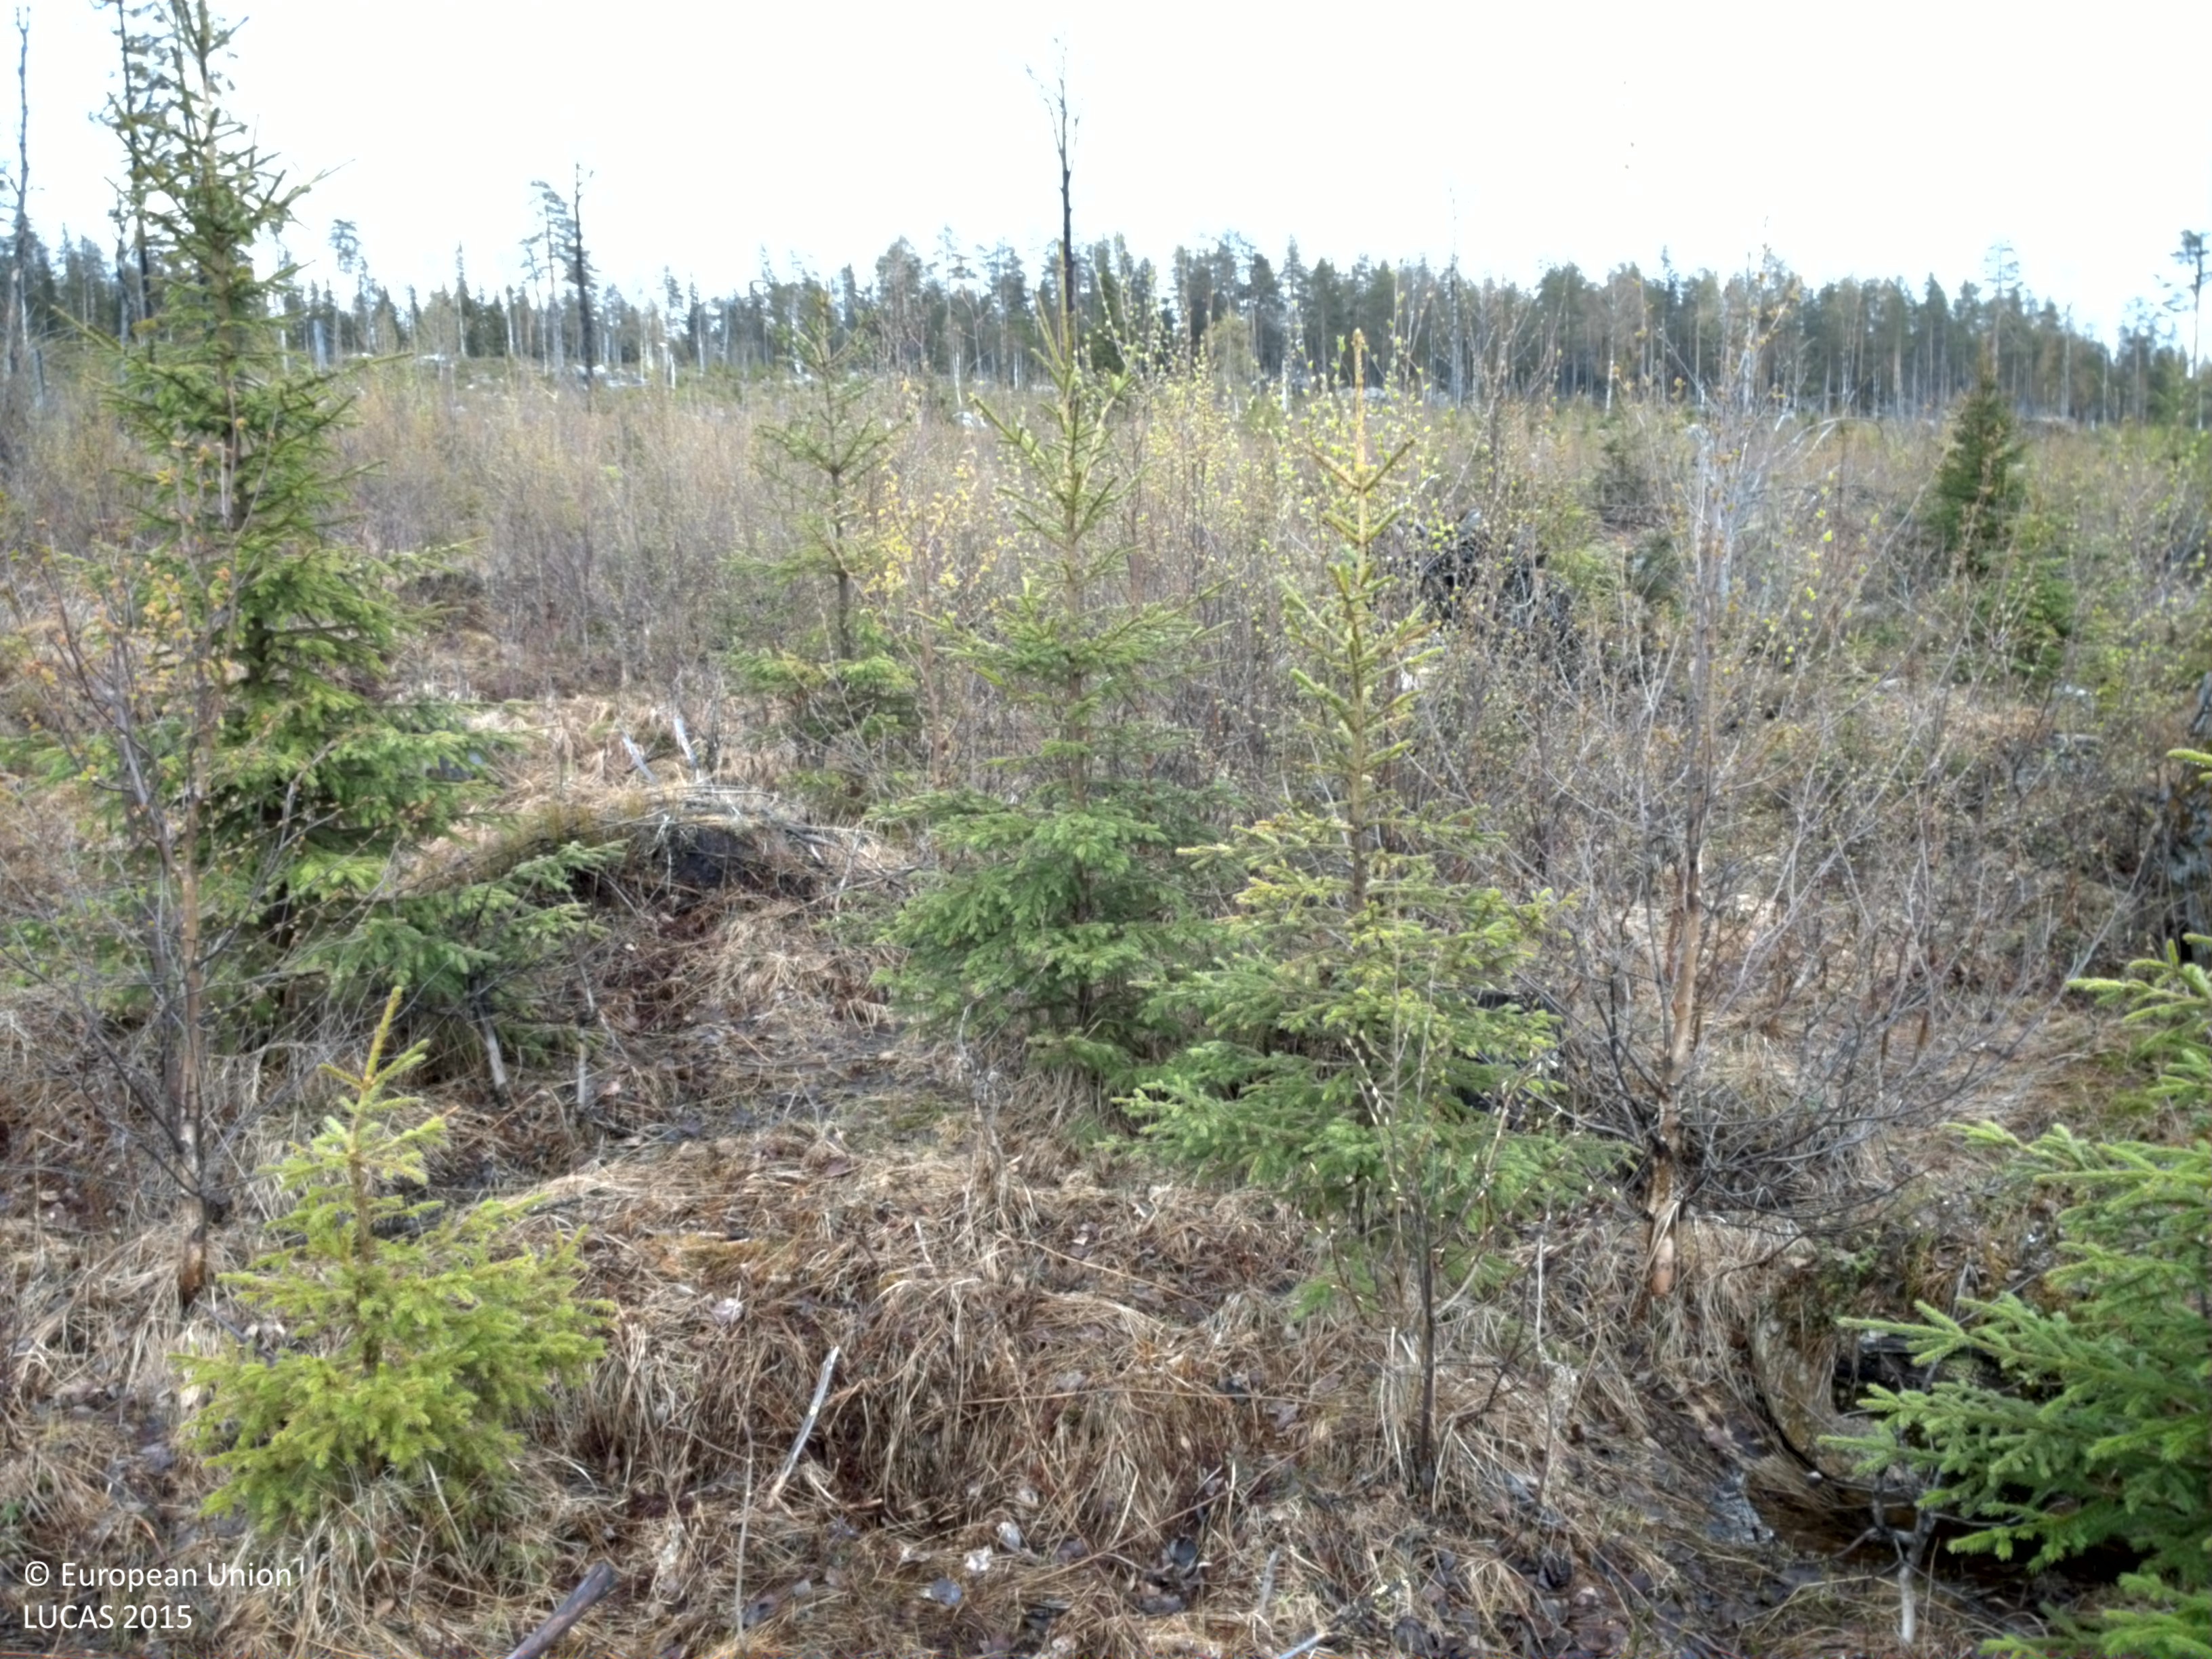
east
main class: Woodland
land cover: Spruce dominated mixed woodland
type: boreal forest
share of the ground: > 75 %
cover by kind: broadleaved forest trees 40 %, coniferous forest trees 35 %, herbaceous plants 15 %, shrubs 10 %
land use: Forestry
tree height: < 5 m
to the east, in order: Spruce dominated mixed woodland; Spruce dominated coniferous woodland; Pine dominated coniferous woodland
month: May
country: SE
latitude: 66.2648
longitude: 23.2760
